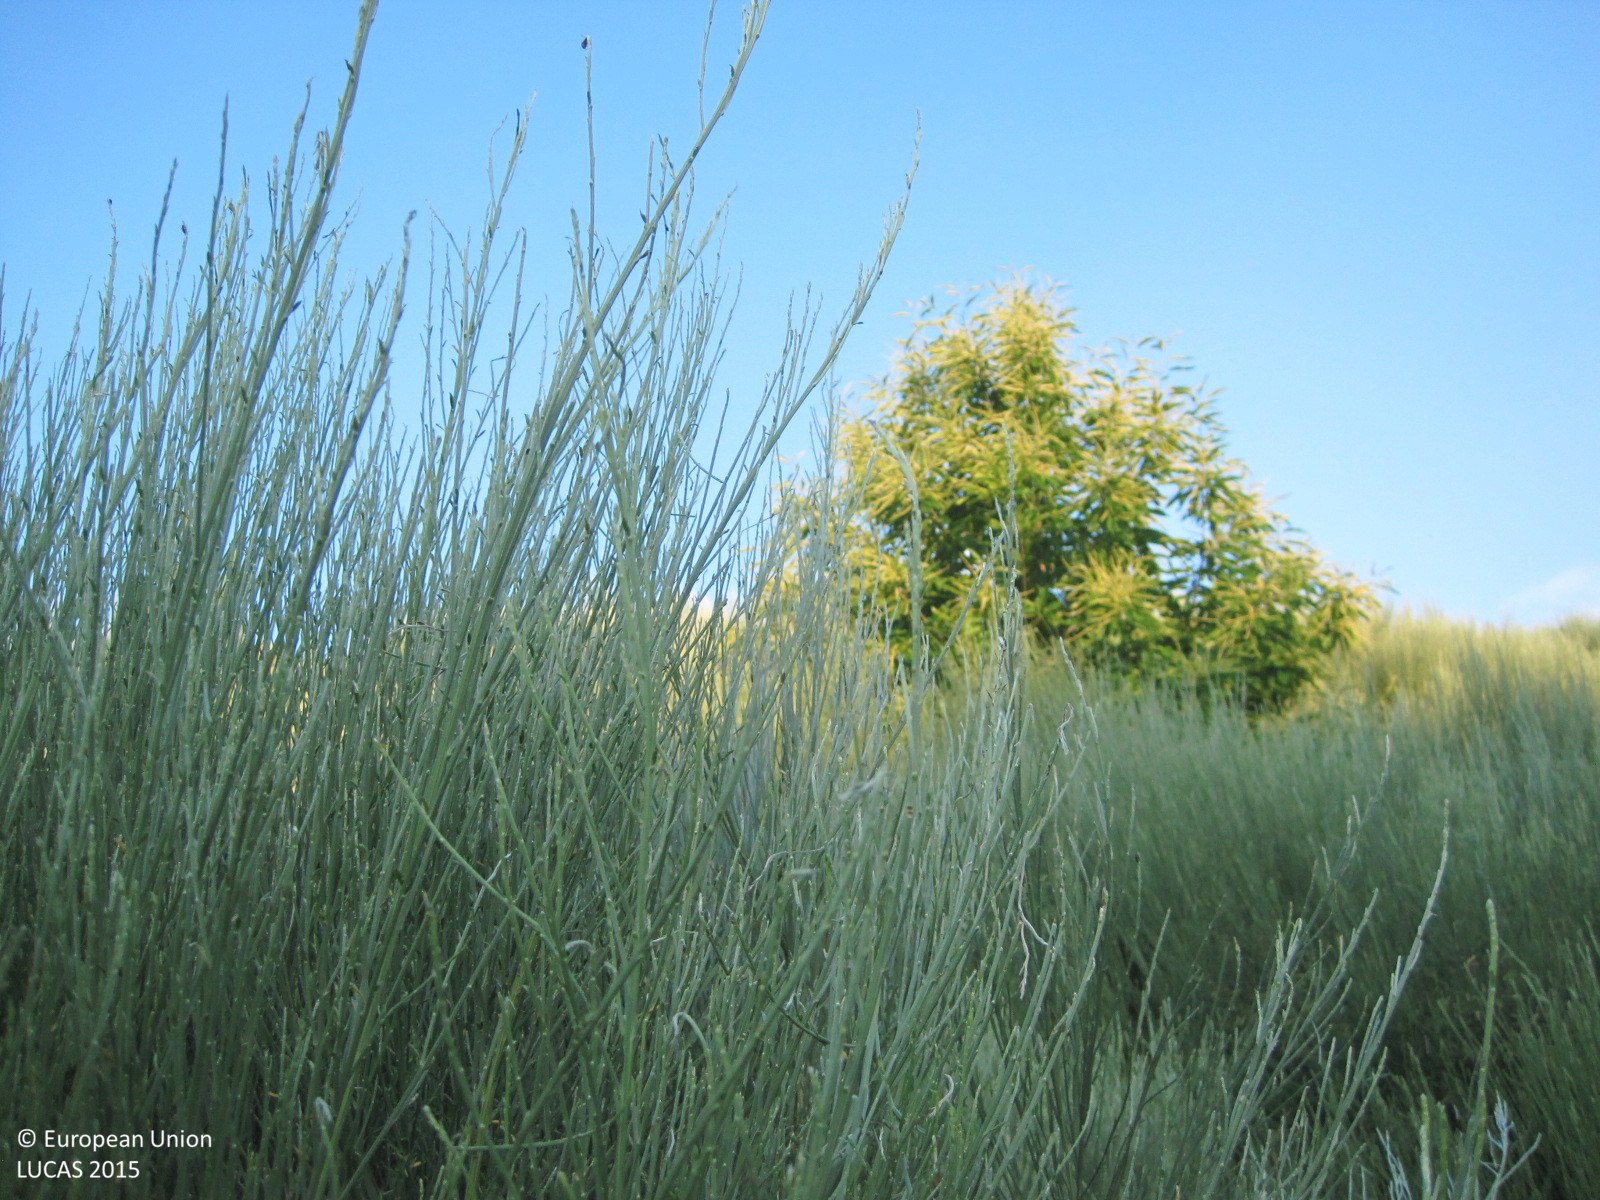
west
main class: Woodland
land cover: Pine dominated coniferous woodland
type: coniferous forest of the mediterranean region
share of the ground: > 75 %
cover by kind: coniferous forest trees 90 %, shrubs 10 %
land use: Forestry
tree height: < 5 m
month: June
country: ES
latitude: 40.2565
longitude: -5.0463
